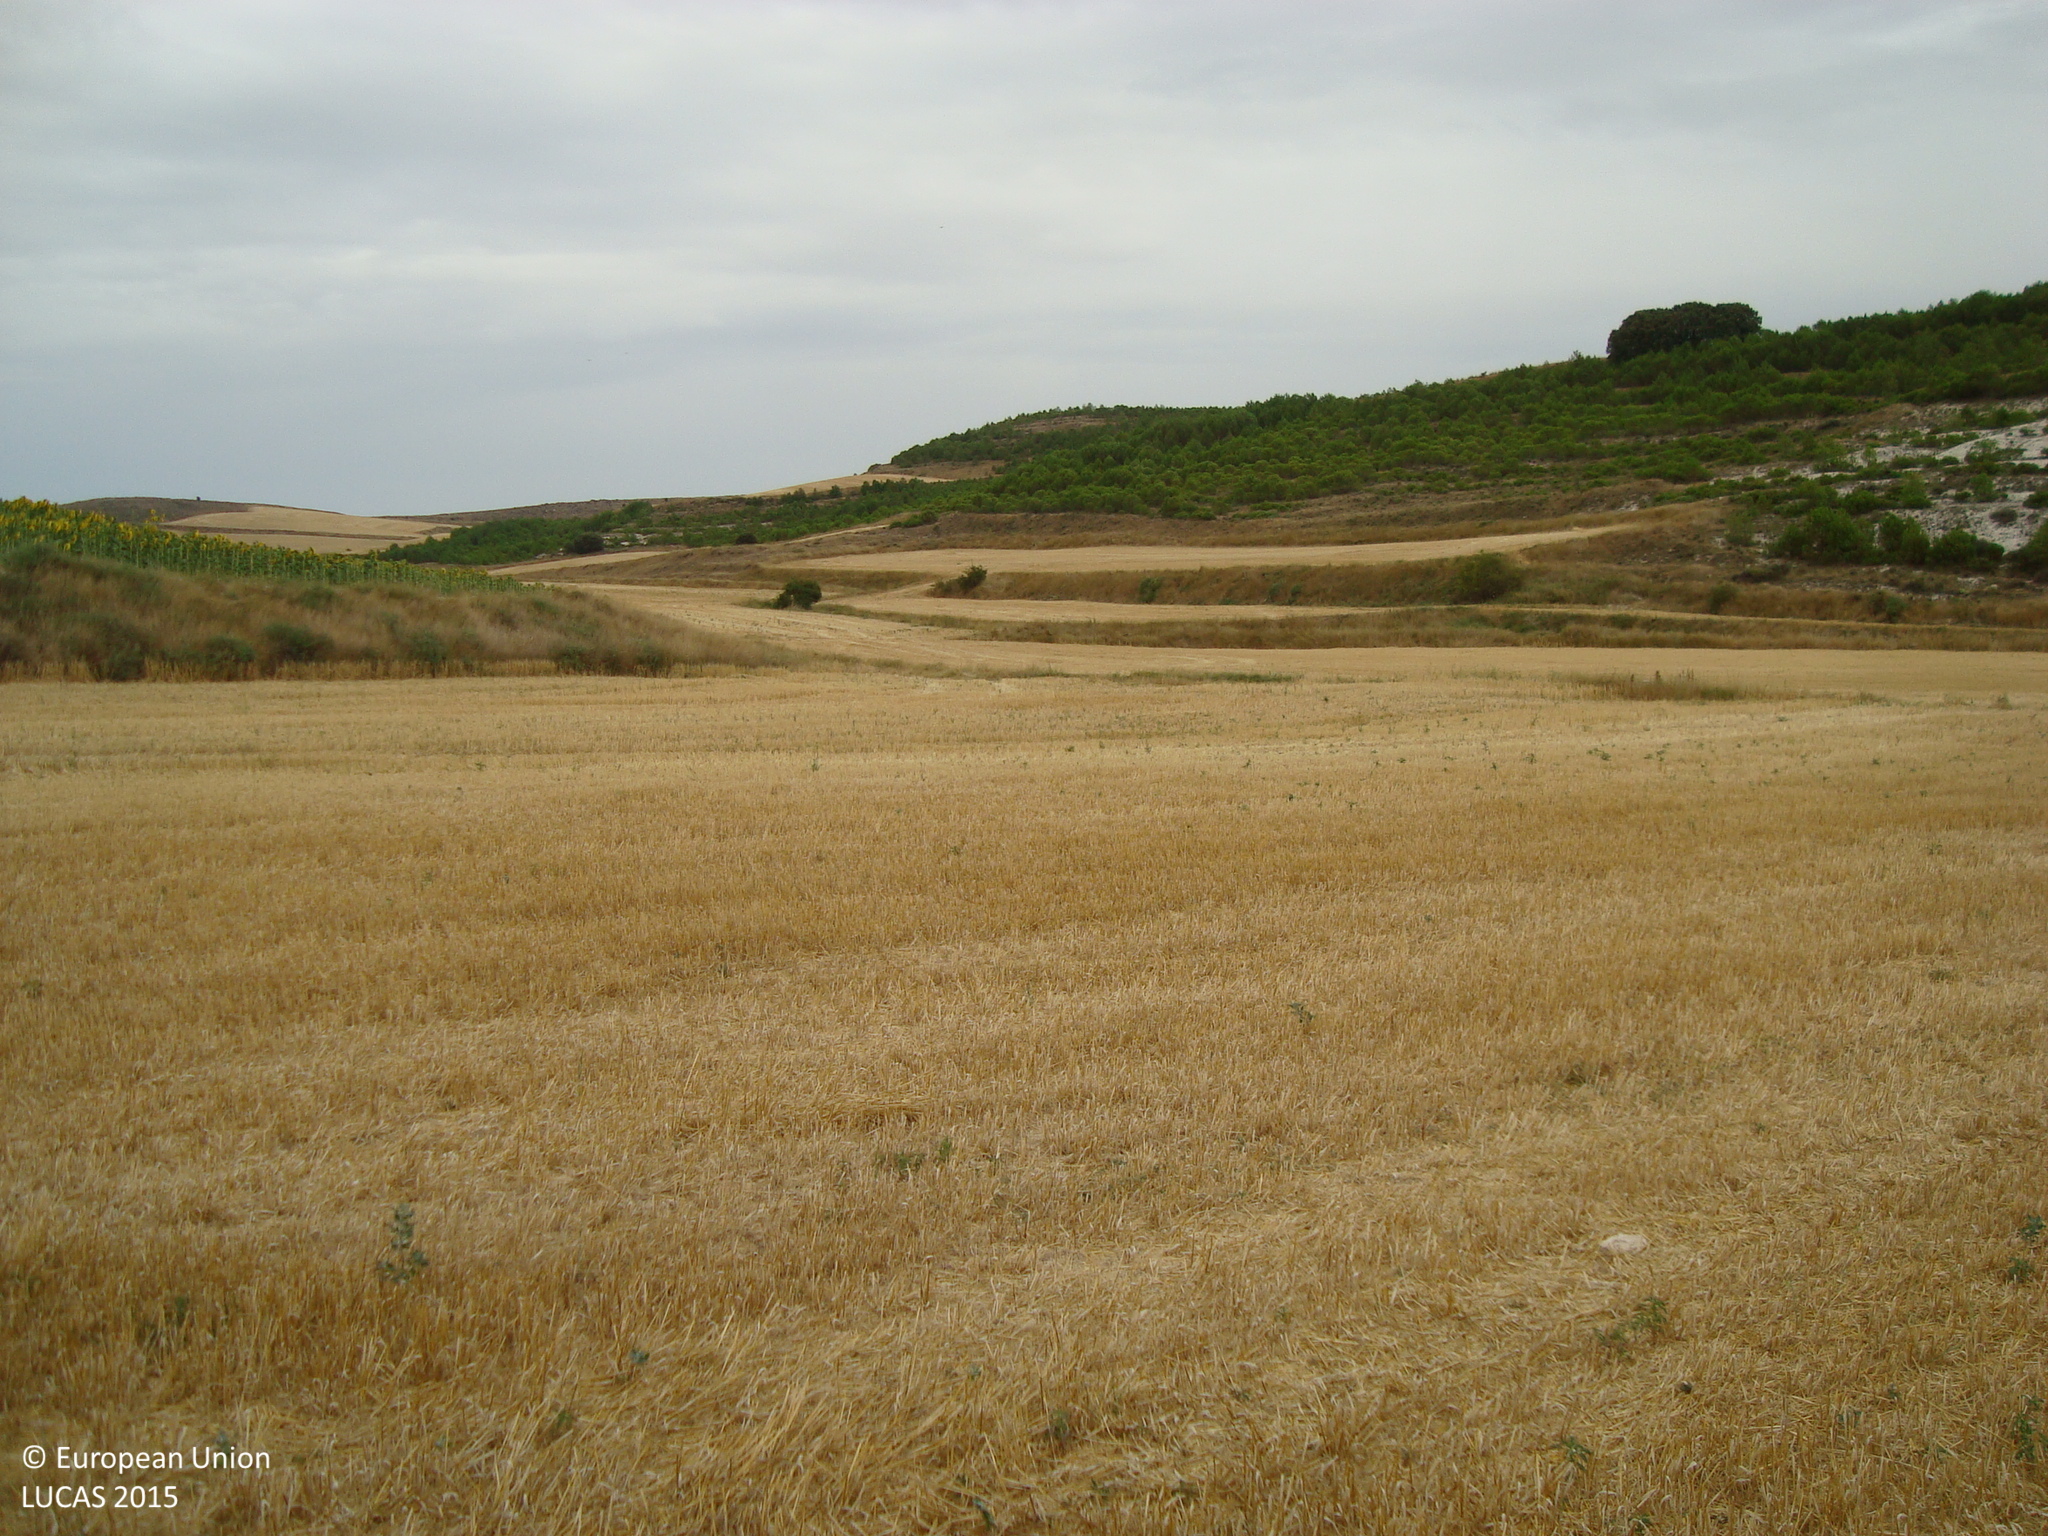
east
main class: Cropland
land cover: Common wheat
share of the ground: > 75 %
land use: Agriculture (excluding fallow land and kitchen gardens)
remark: Harvested field
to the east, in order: Common wheat; Tracks; Common wheat; Rivers and streams; Grassland with sparse tree/shrub cover; Common wheat; Grassland with sparse tree/shrub cover; Pine dominated coniferous woodland
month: August
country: ES
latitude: 42.2164
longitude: -3.9332
